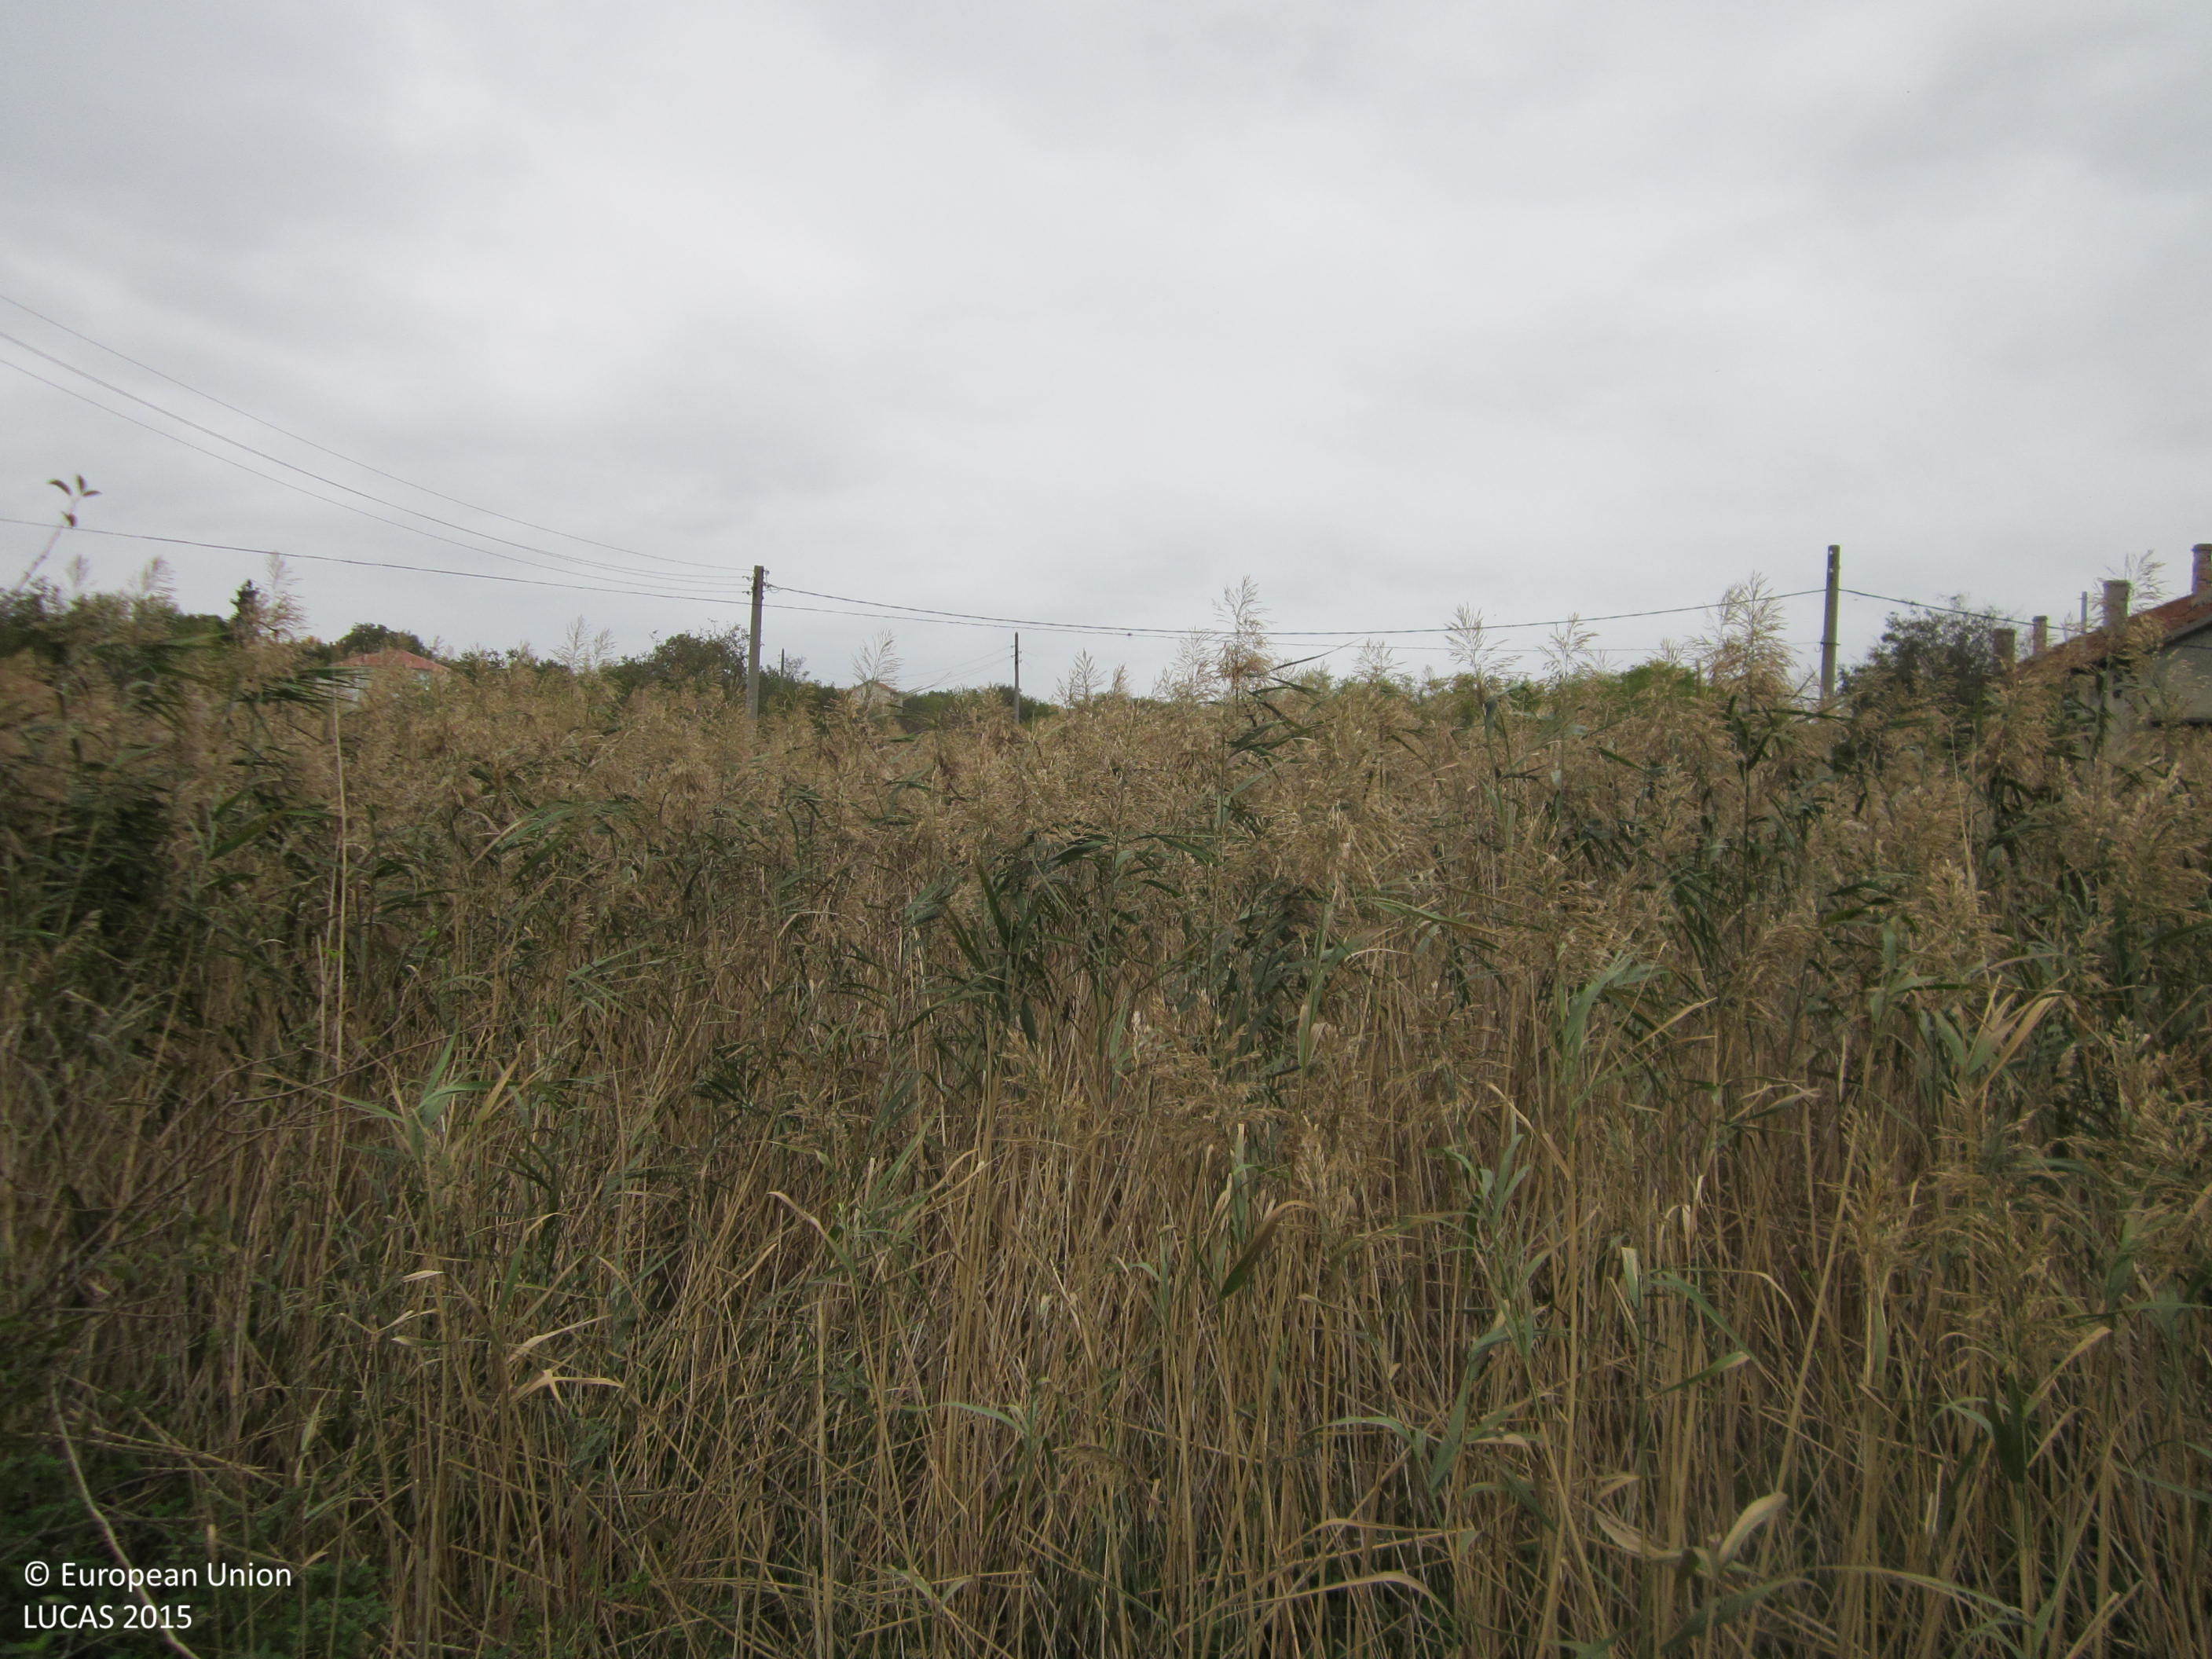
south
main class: Grassland
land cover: Spontaneously vegetated surfaces
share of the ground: > 75 %
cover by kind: herbaceous plants 100 %
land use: Fallow land
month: October
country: BG
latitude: 42.7165
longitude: 27.0951
